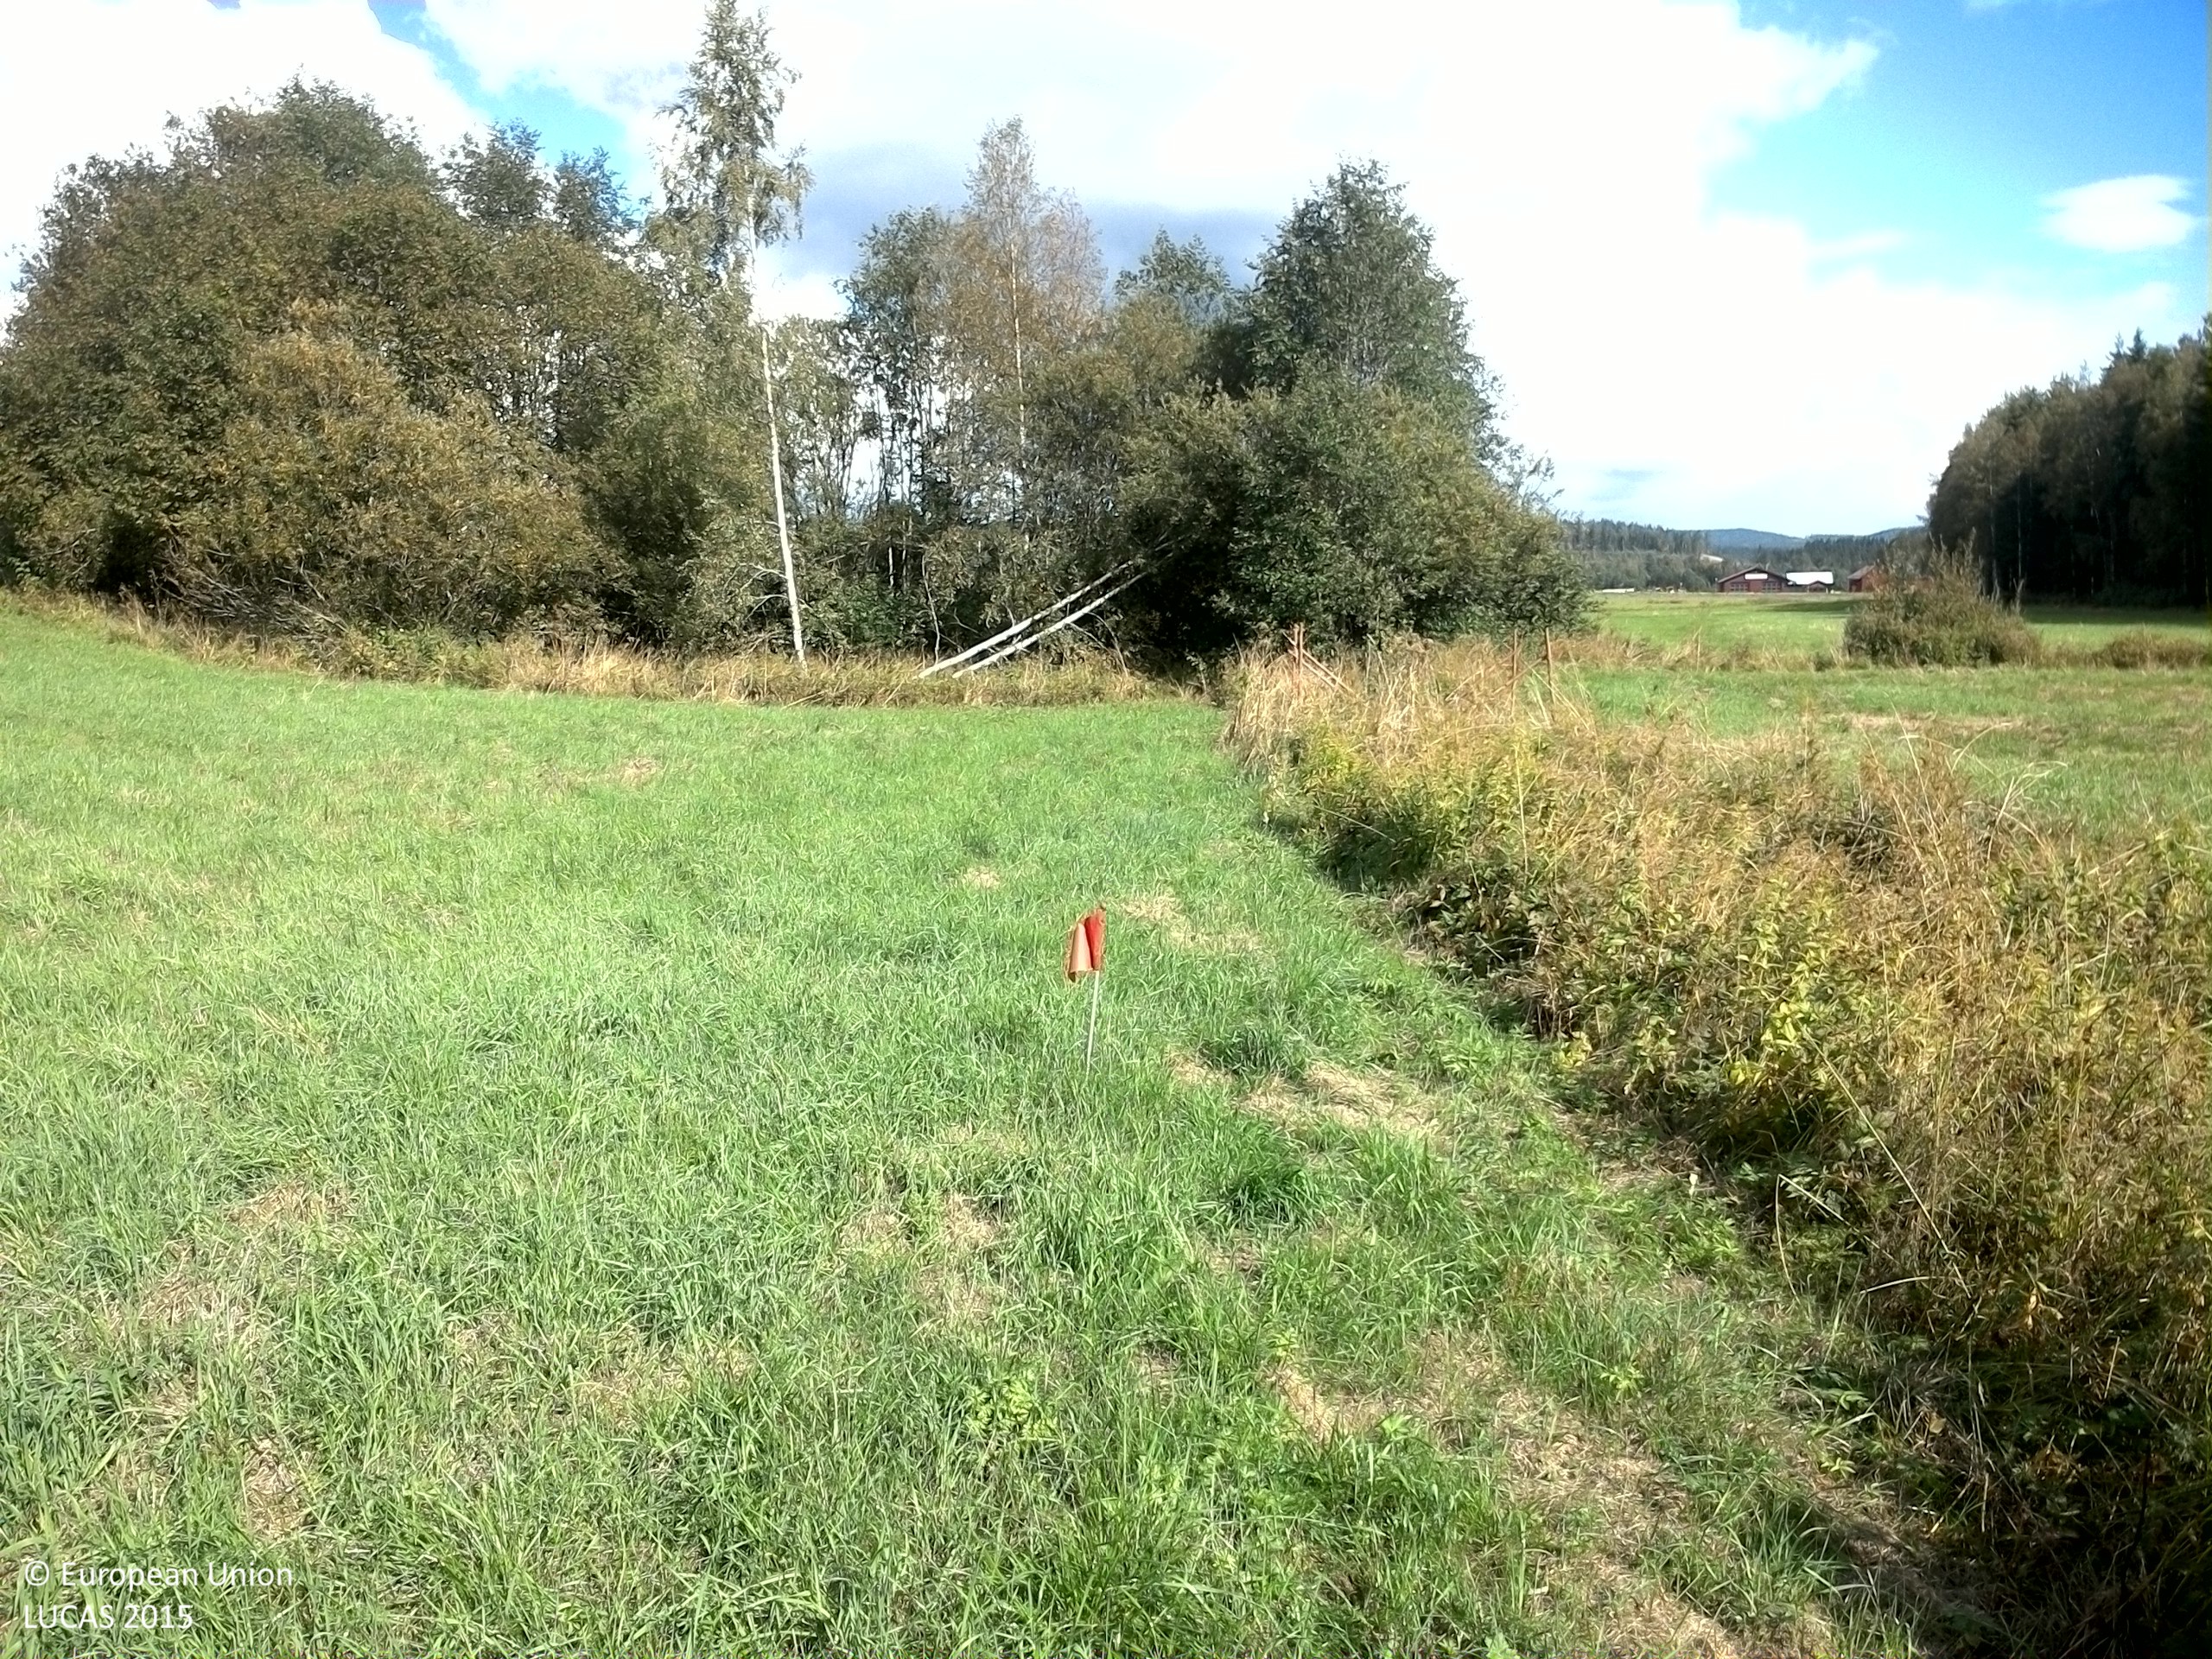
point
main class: Grassland
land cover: Grassland without tree/shrub cover
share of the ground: > 75 %
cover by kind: herbaceous plants 90 %, consolidated bare surface 10 %
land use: Agriculture (excluding fallow land and kitchen gardens)
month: September
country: SE
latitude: 59.8025
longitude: 13.1823
